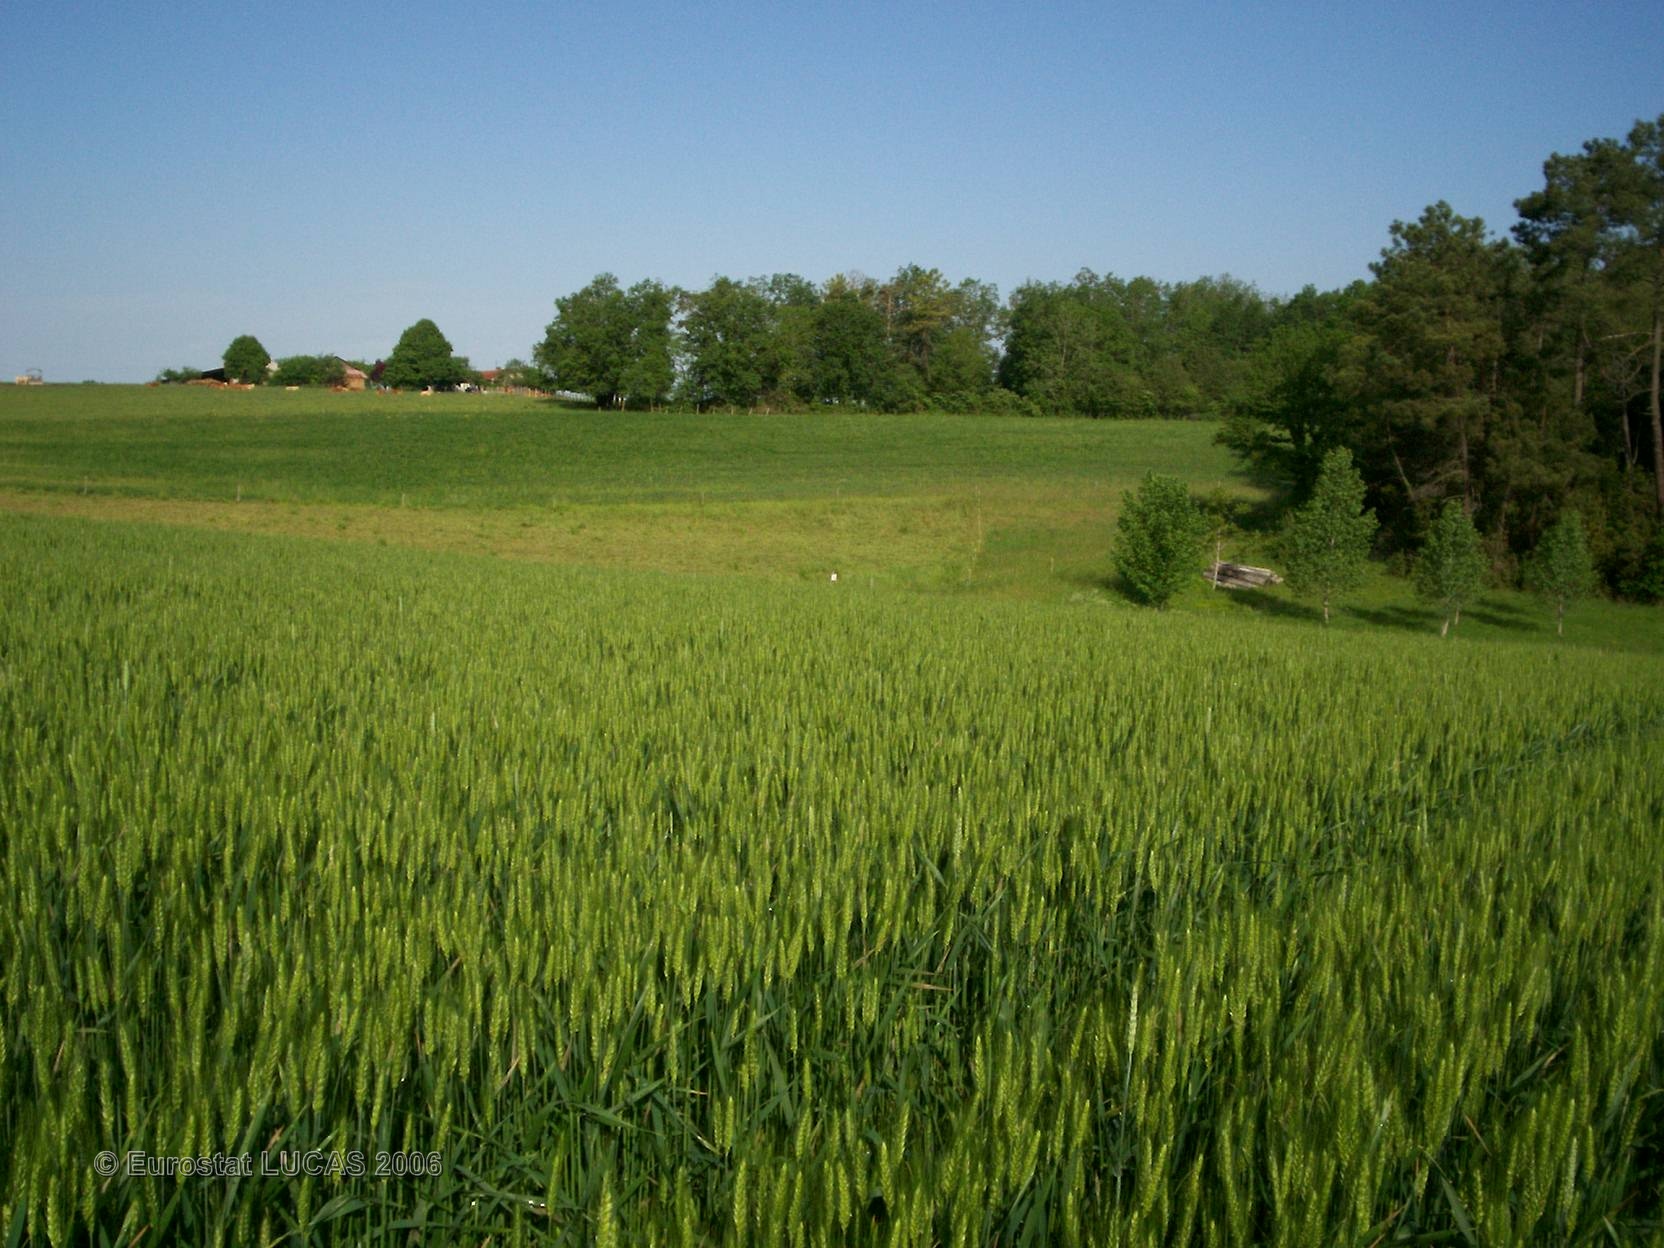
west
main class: Cropland
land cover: Triticale
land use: Agriculture (excluding fallow land and kitchen gardens)
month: May
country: FR
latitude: 45.3233
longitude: 0.6374
